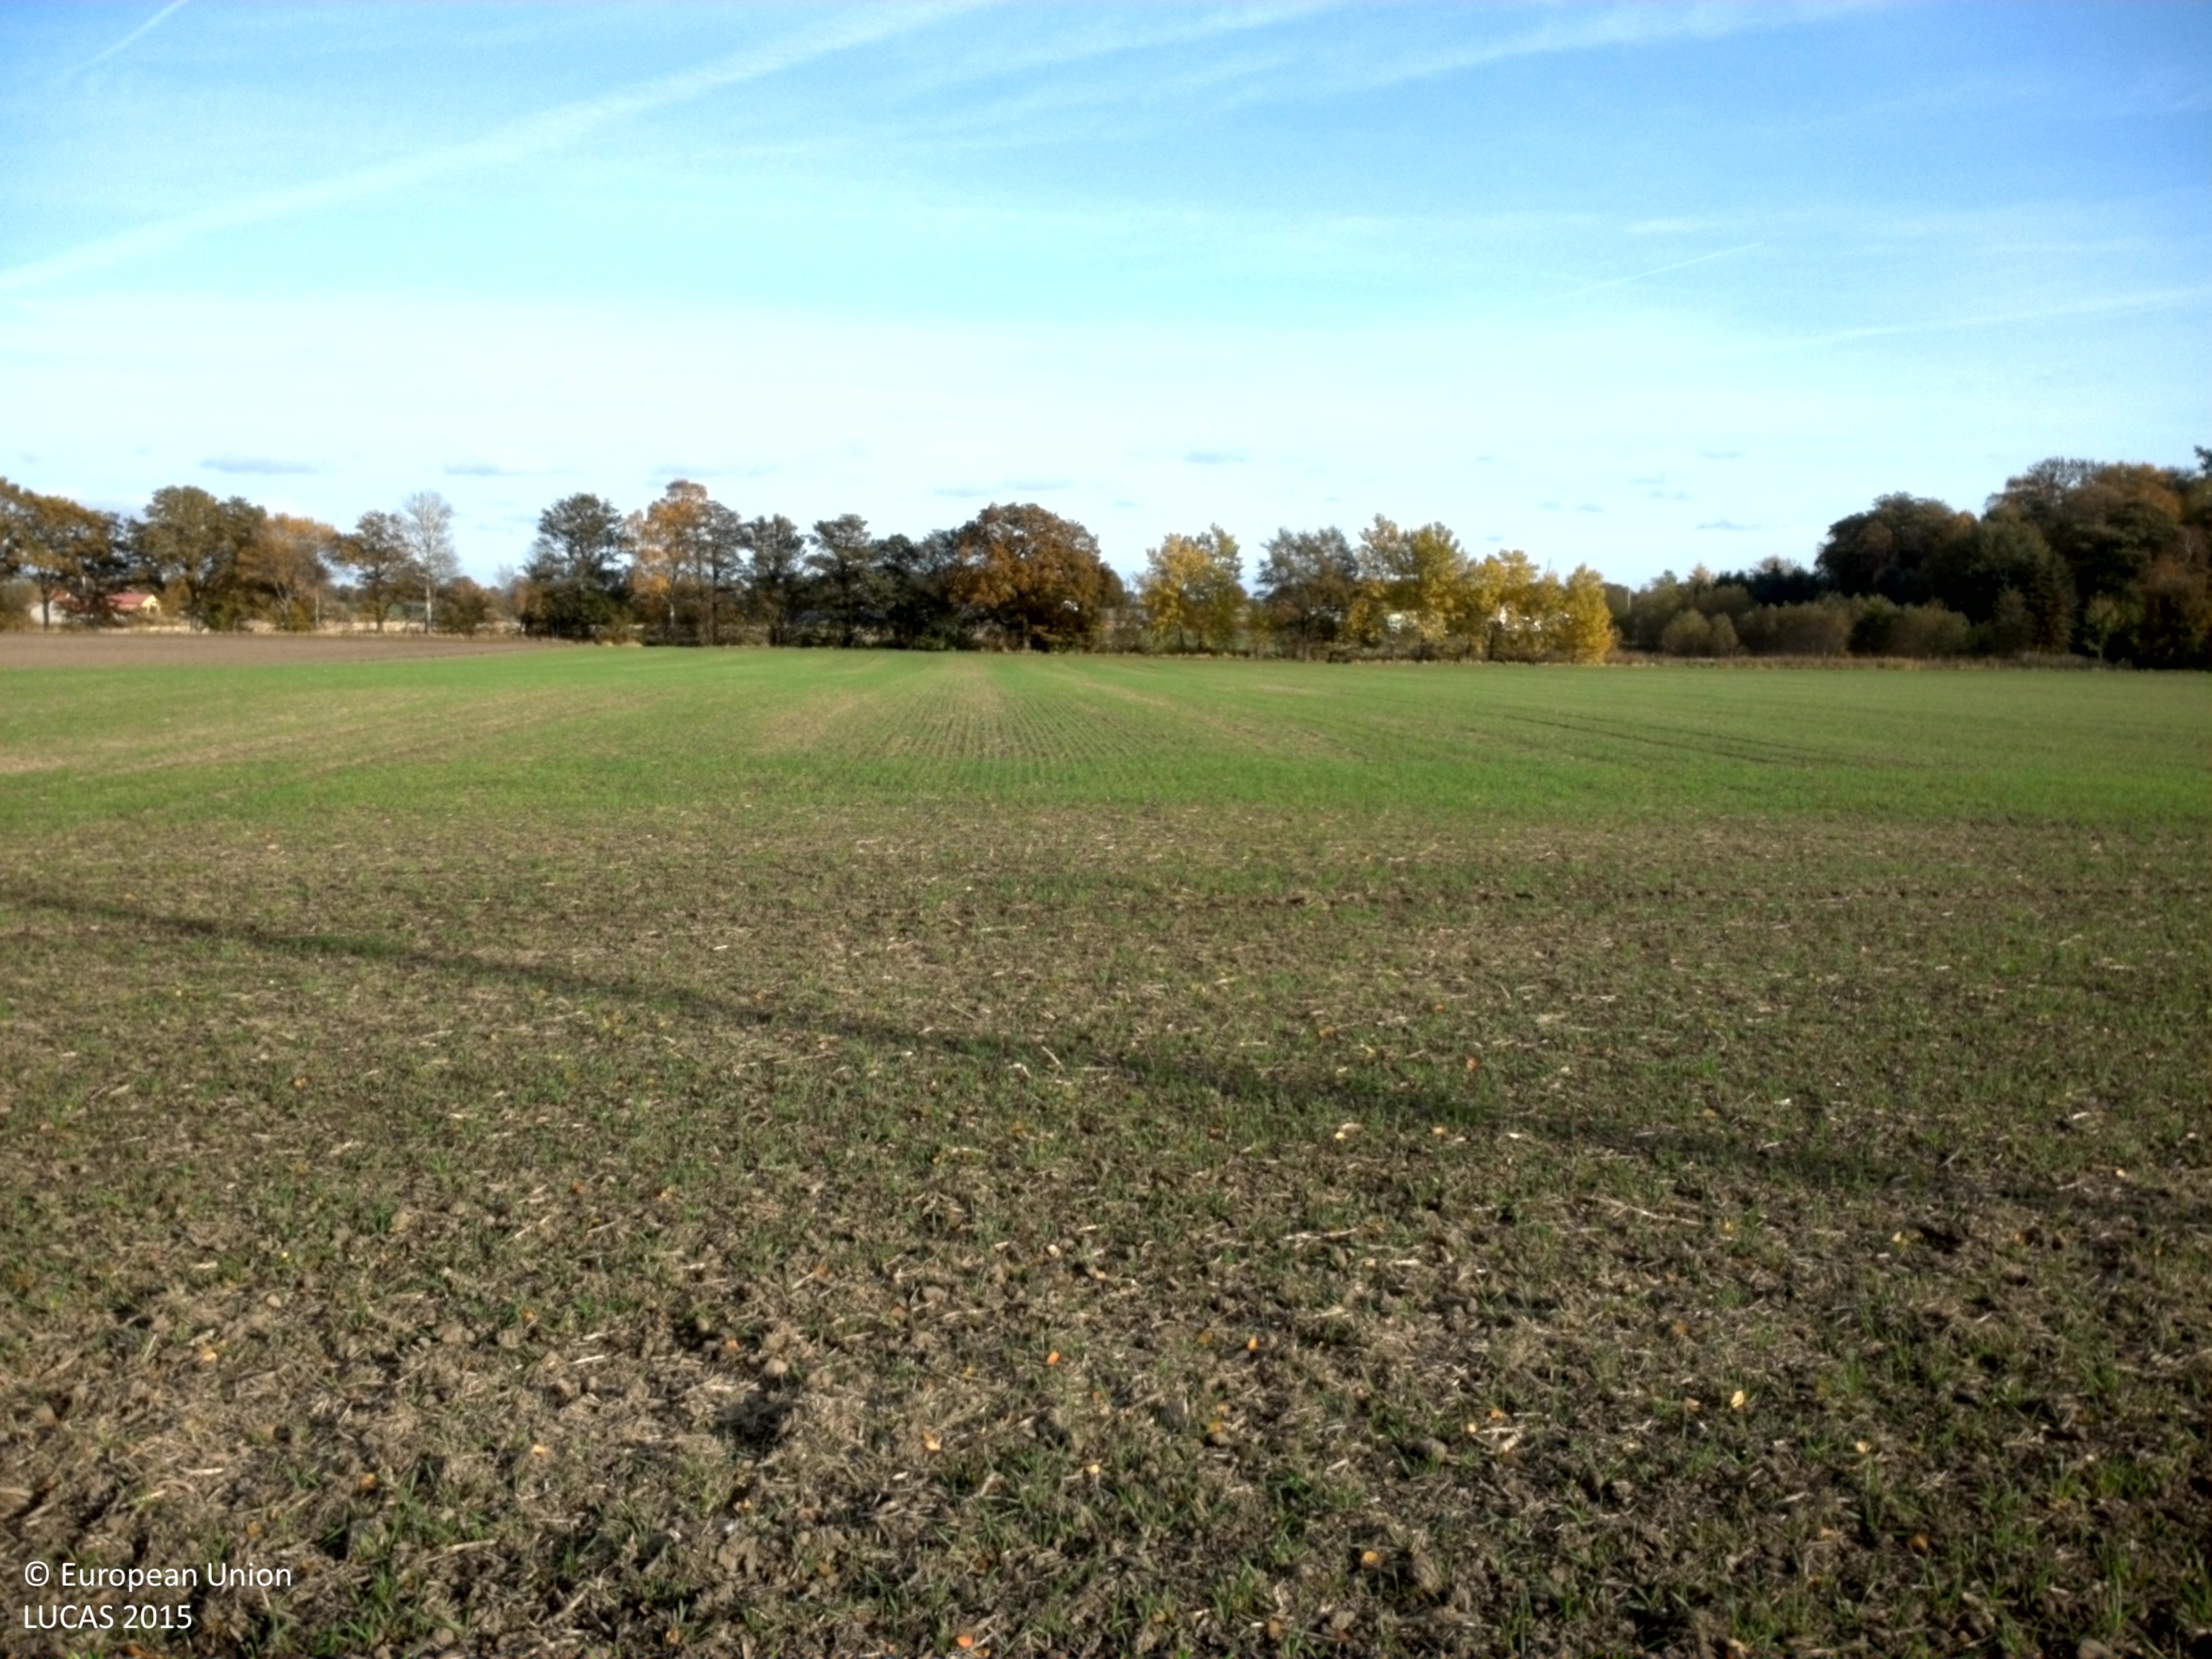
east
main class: Cropland
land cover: Common wheat
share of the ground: < 10 %
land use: Agriculture (excluding fallow land and kitchen gardens)
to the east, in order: Grass margins; Common wheat; Grass margins; Abandoned hedges; Ditches and canals; Abandoned hedges; Fences; Grassland without tree/shrub cover
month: October
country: SE
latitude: 56.0305
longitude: 12.8380
